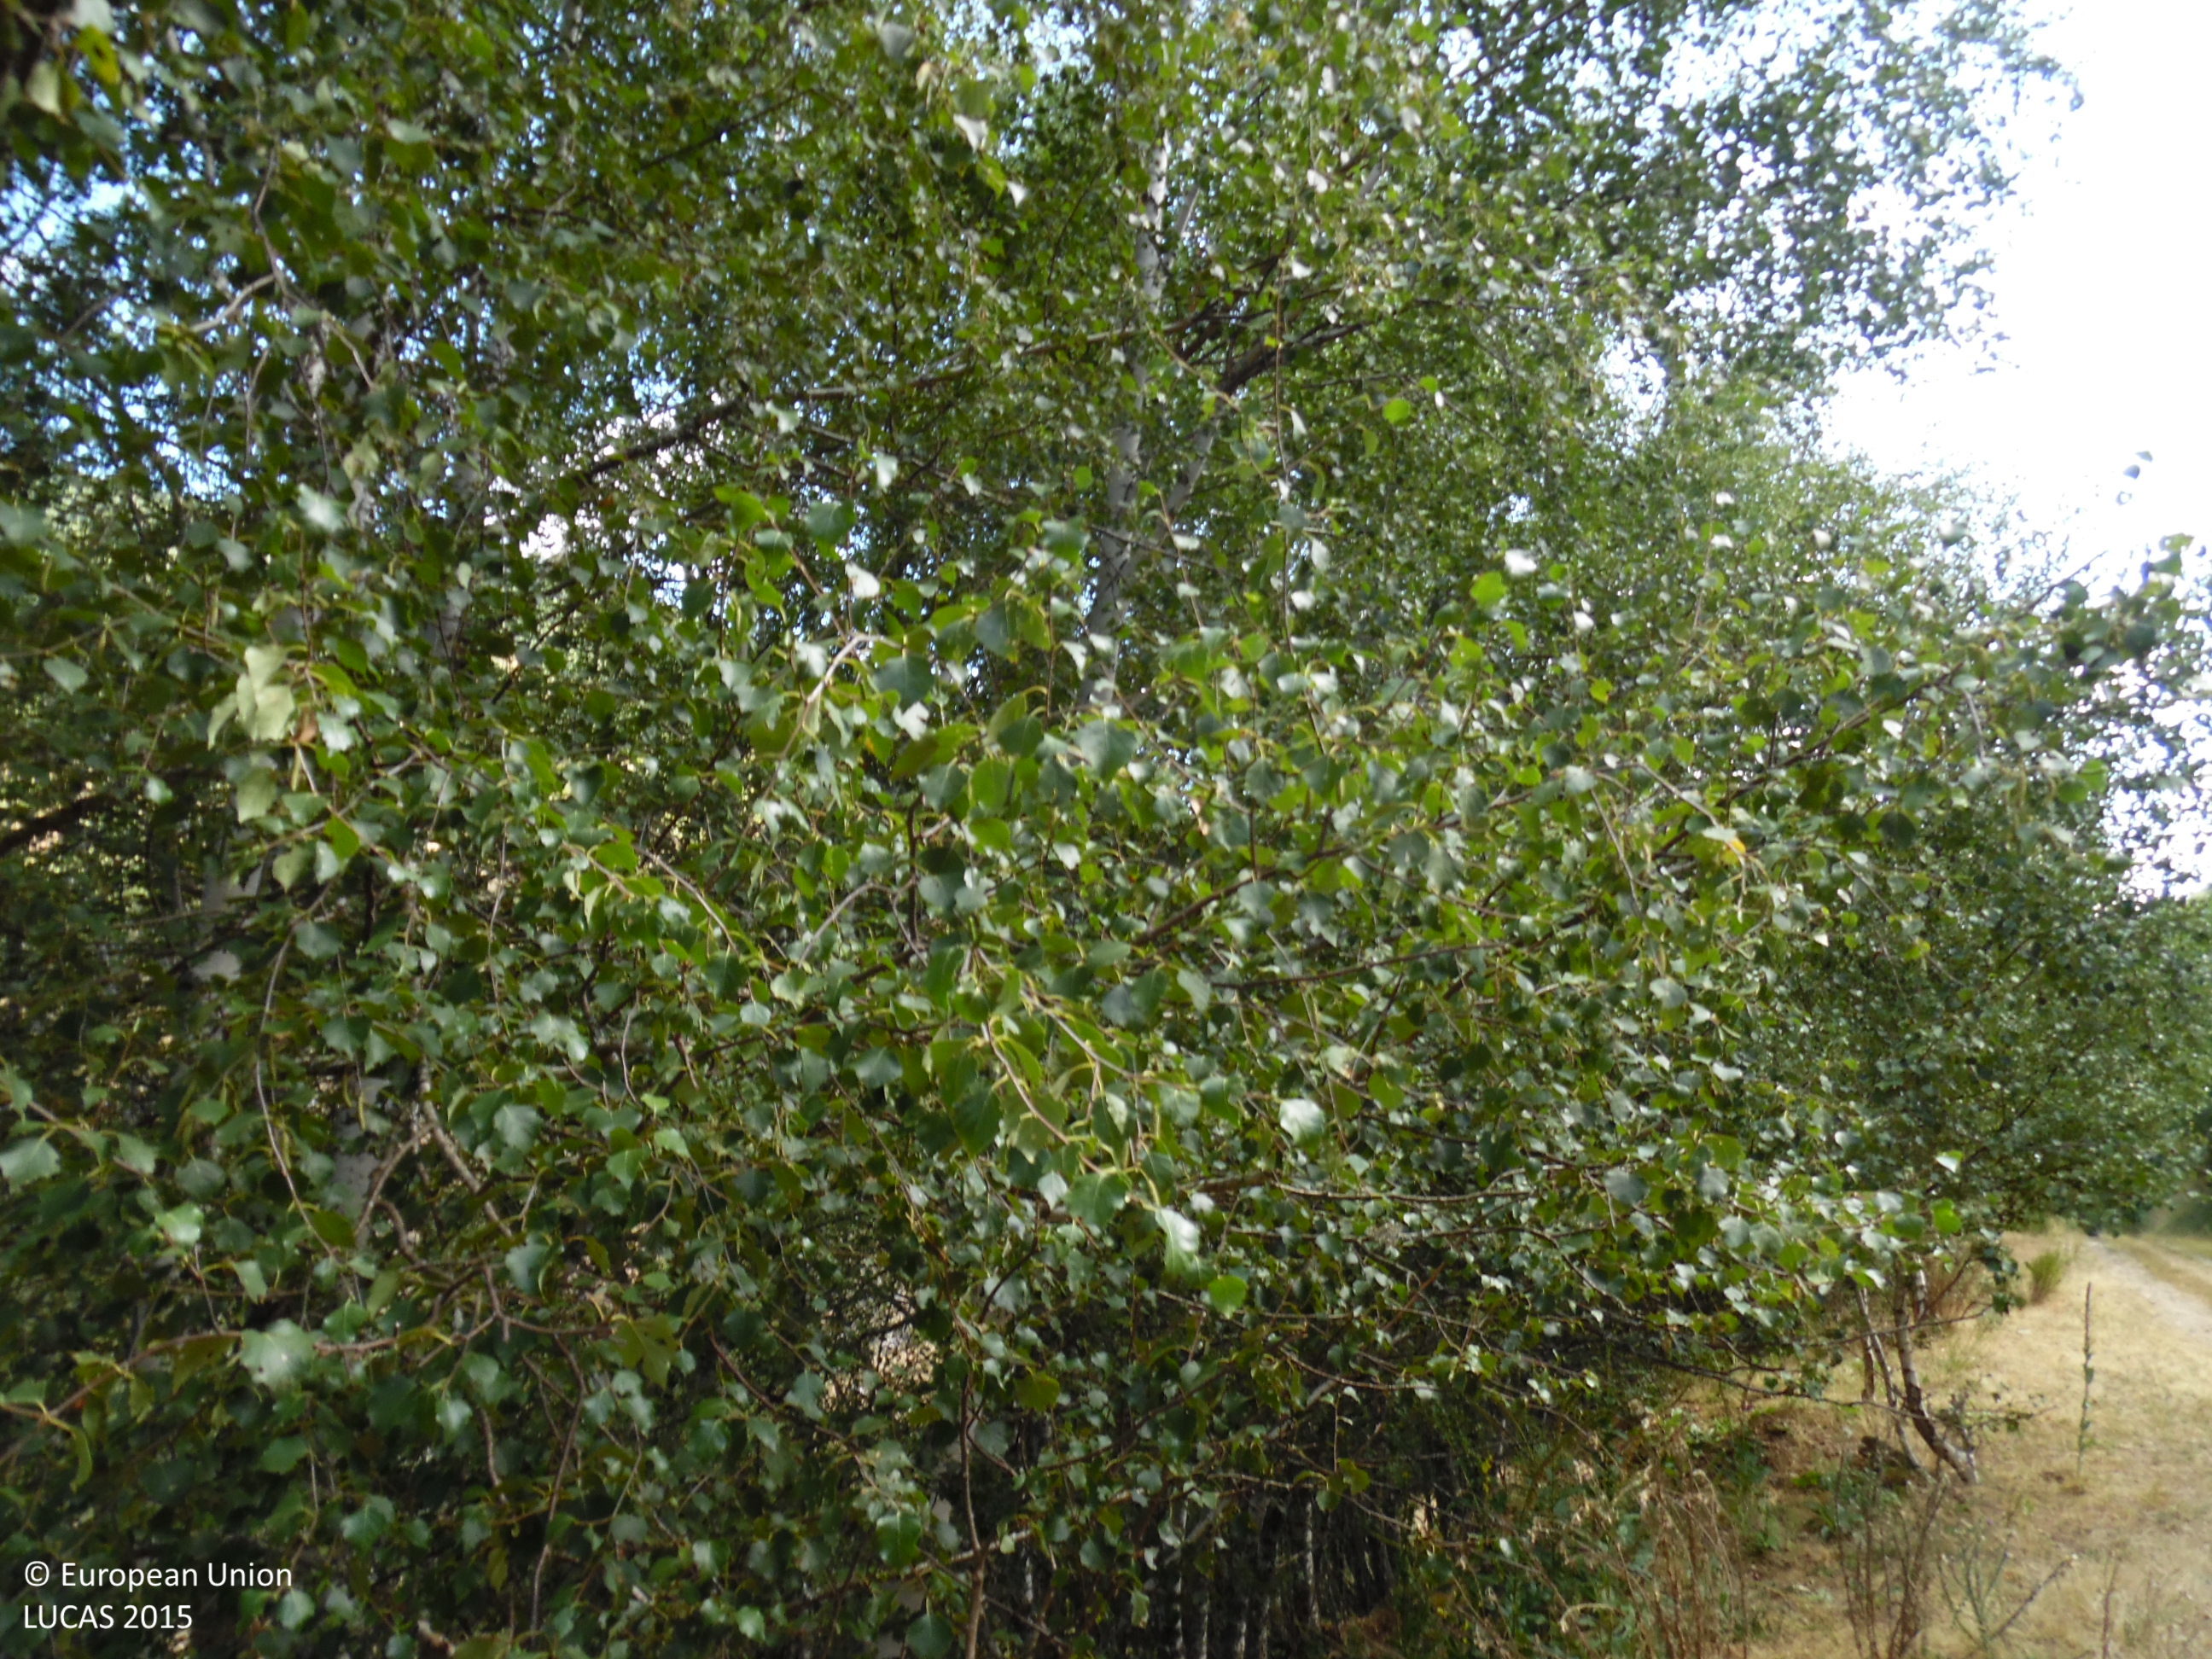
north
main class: Woodland
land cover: Broadleaved woodland
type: thermophilous deciduous forest
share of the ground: > 75 %
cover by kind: broadleaved forest trees 100 %
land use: Forestry
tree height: > 5 m
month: August
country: ES
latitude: 42.8148
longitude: -6.1711
